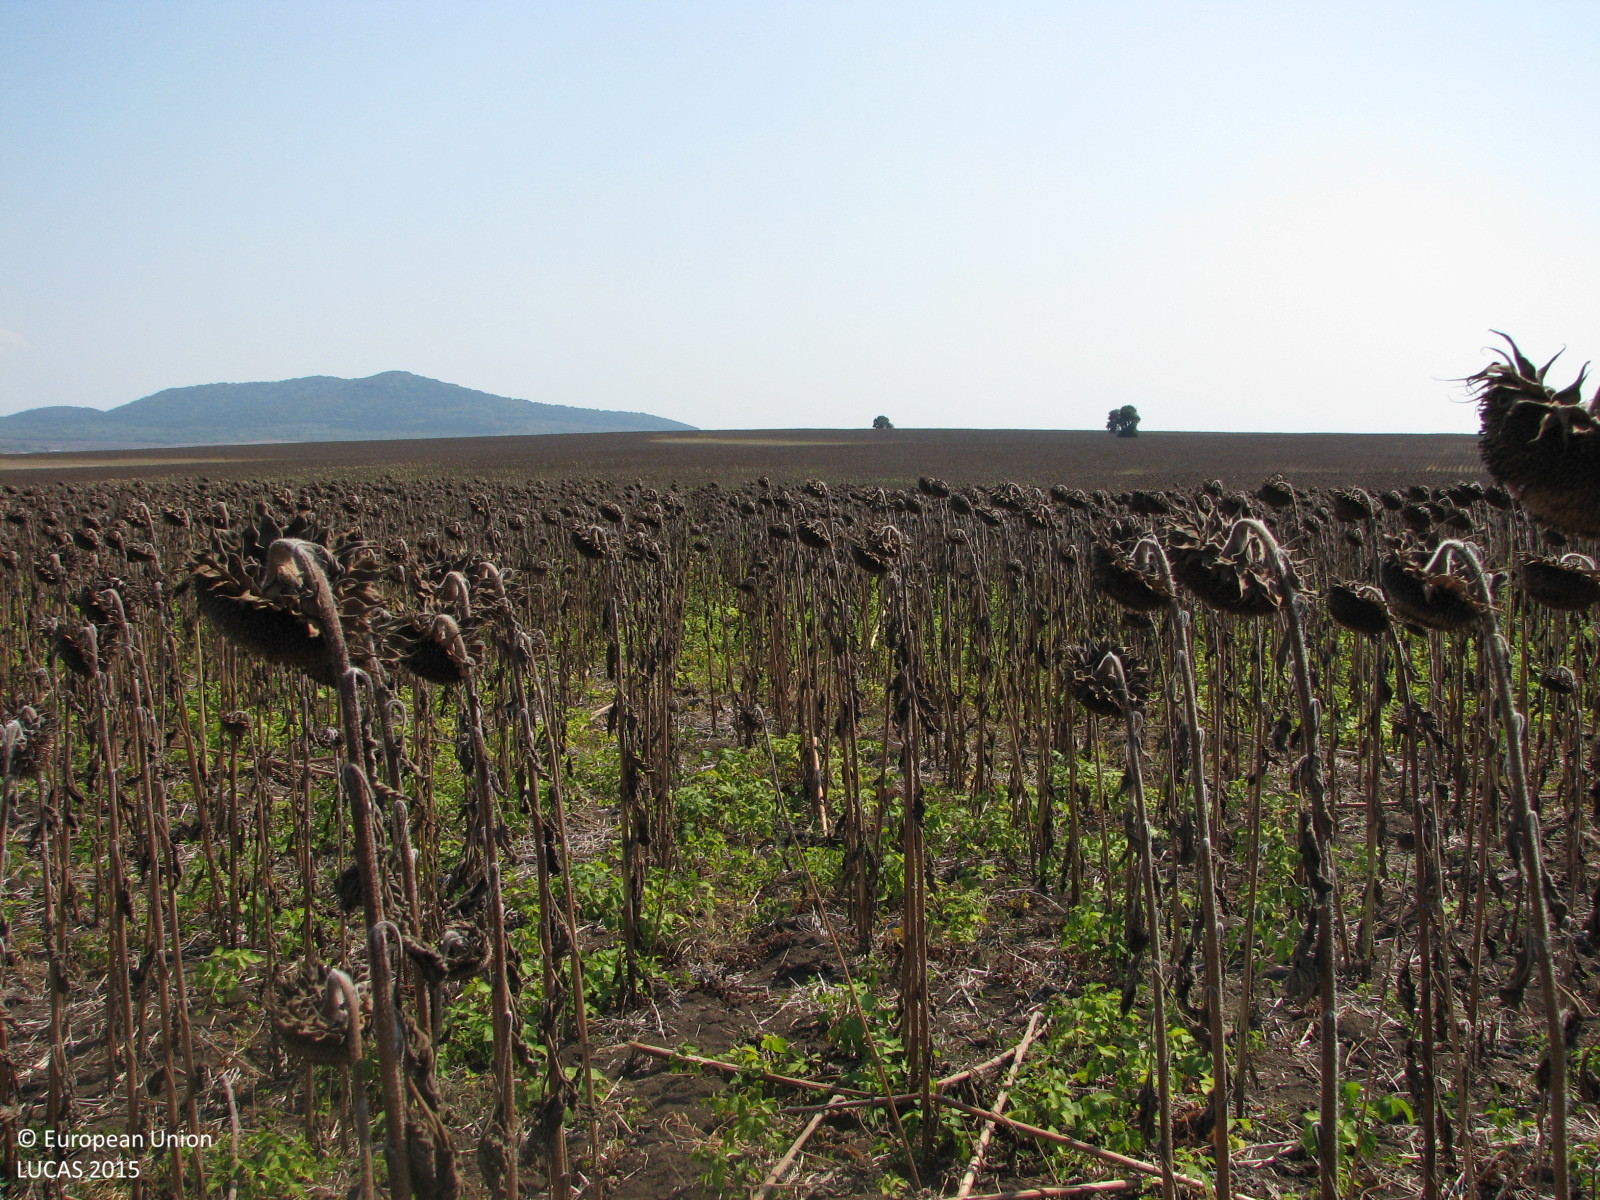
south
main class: Cropland
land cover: Sunflower
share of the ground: 50 - 75 %
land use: Agriculture (excluding fallow land and kitchen gardens)
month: September
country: BG
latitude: 42.4020
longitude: 26.7792
